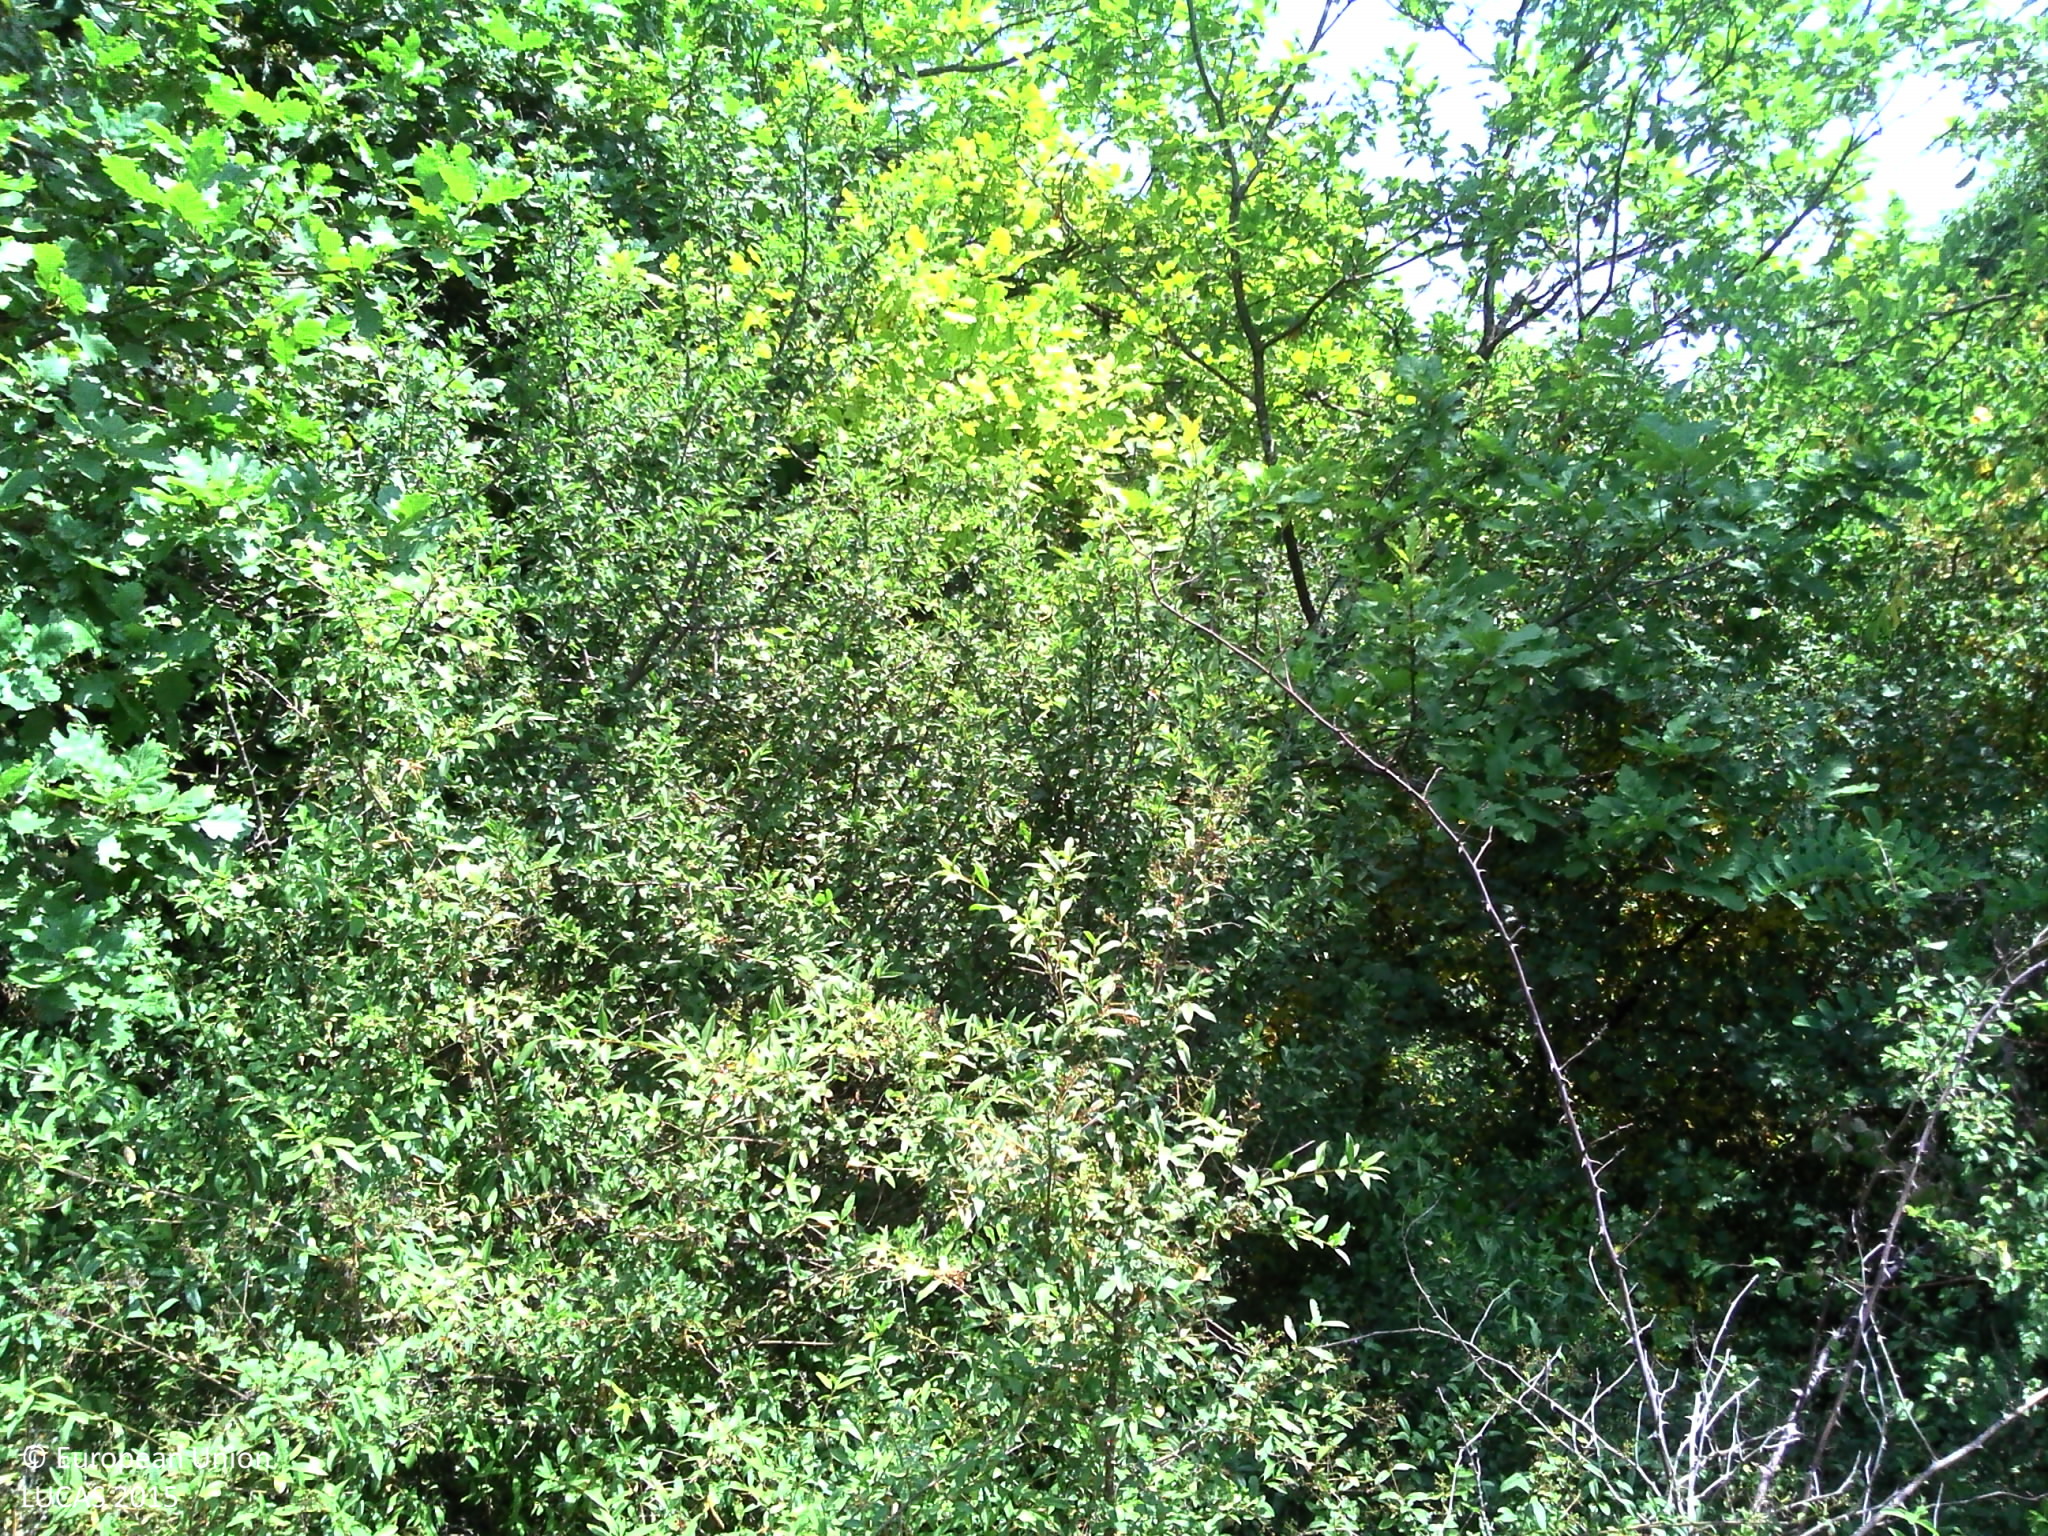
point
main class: Woodland
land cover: Broadleaved woodland
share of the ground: > 75 %
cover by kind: broadleaved forest trees 90 %, herbaceous plants 10 %
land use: Forestry
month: July
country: FR
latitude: 45.8028
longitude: 5.4363
